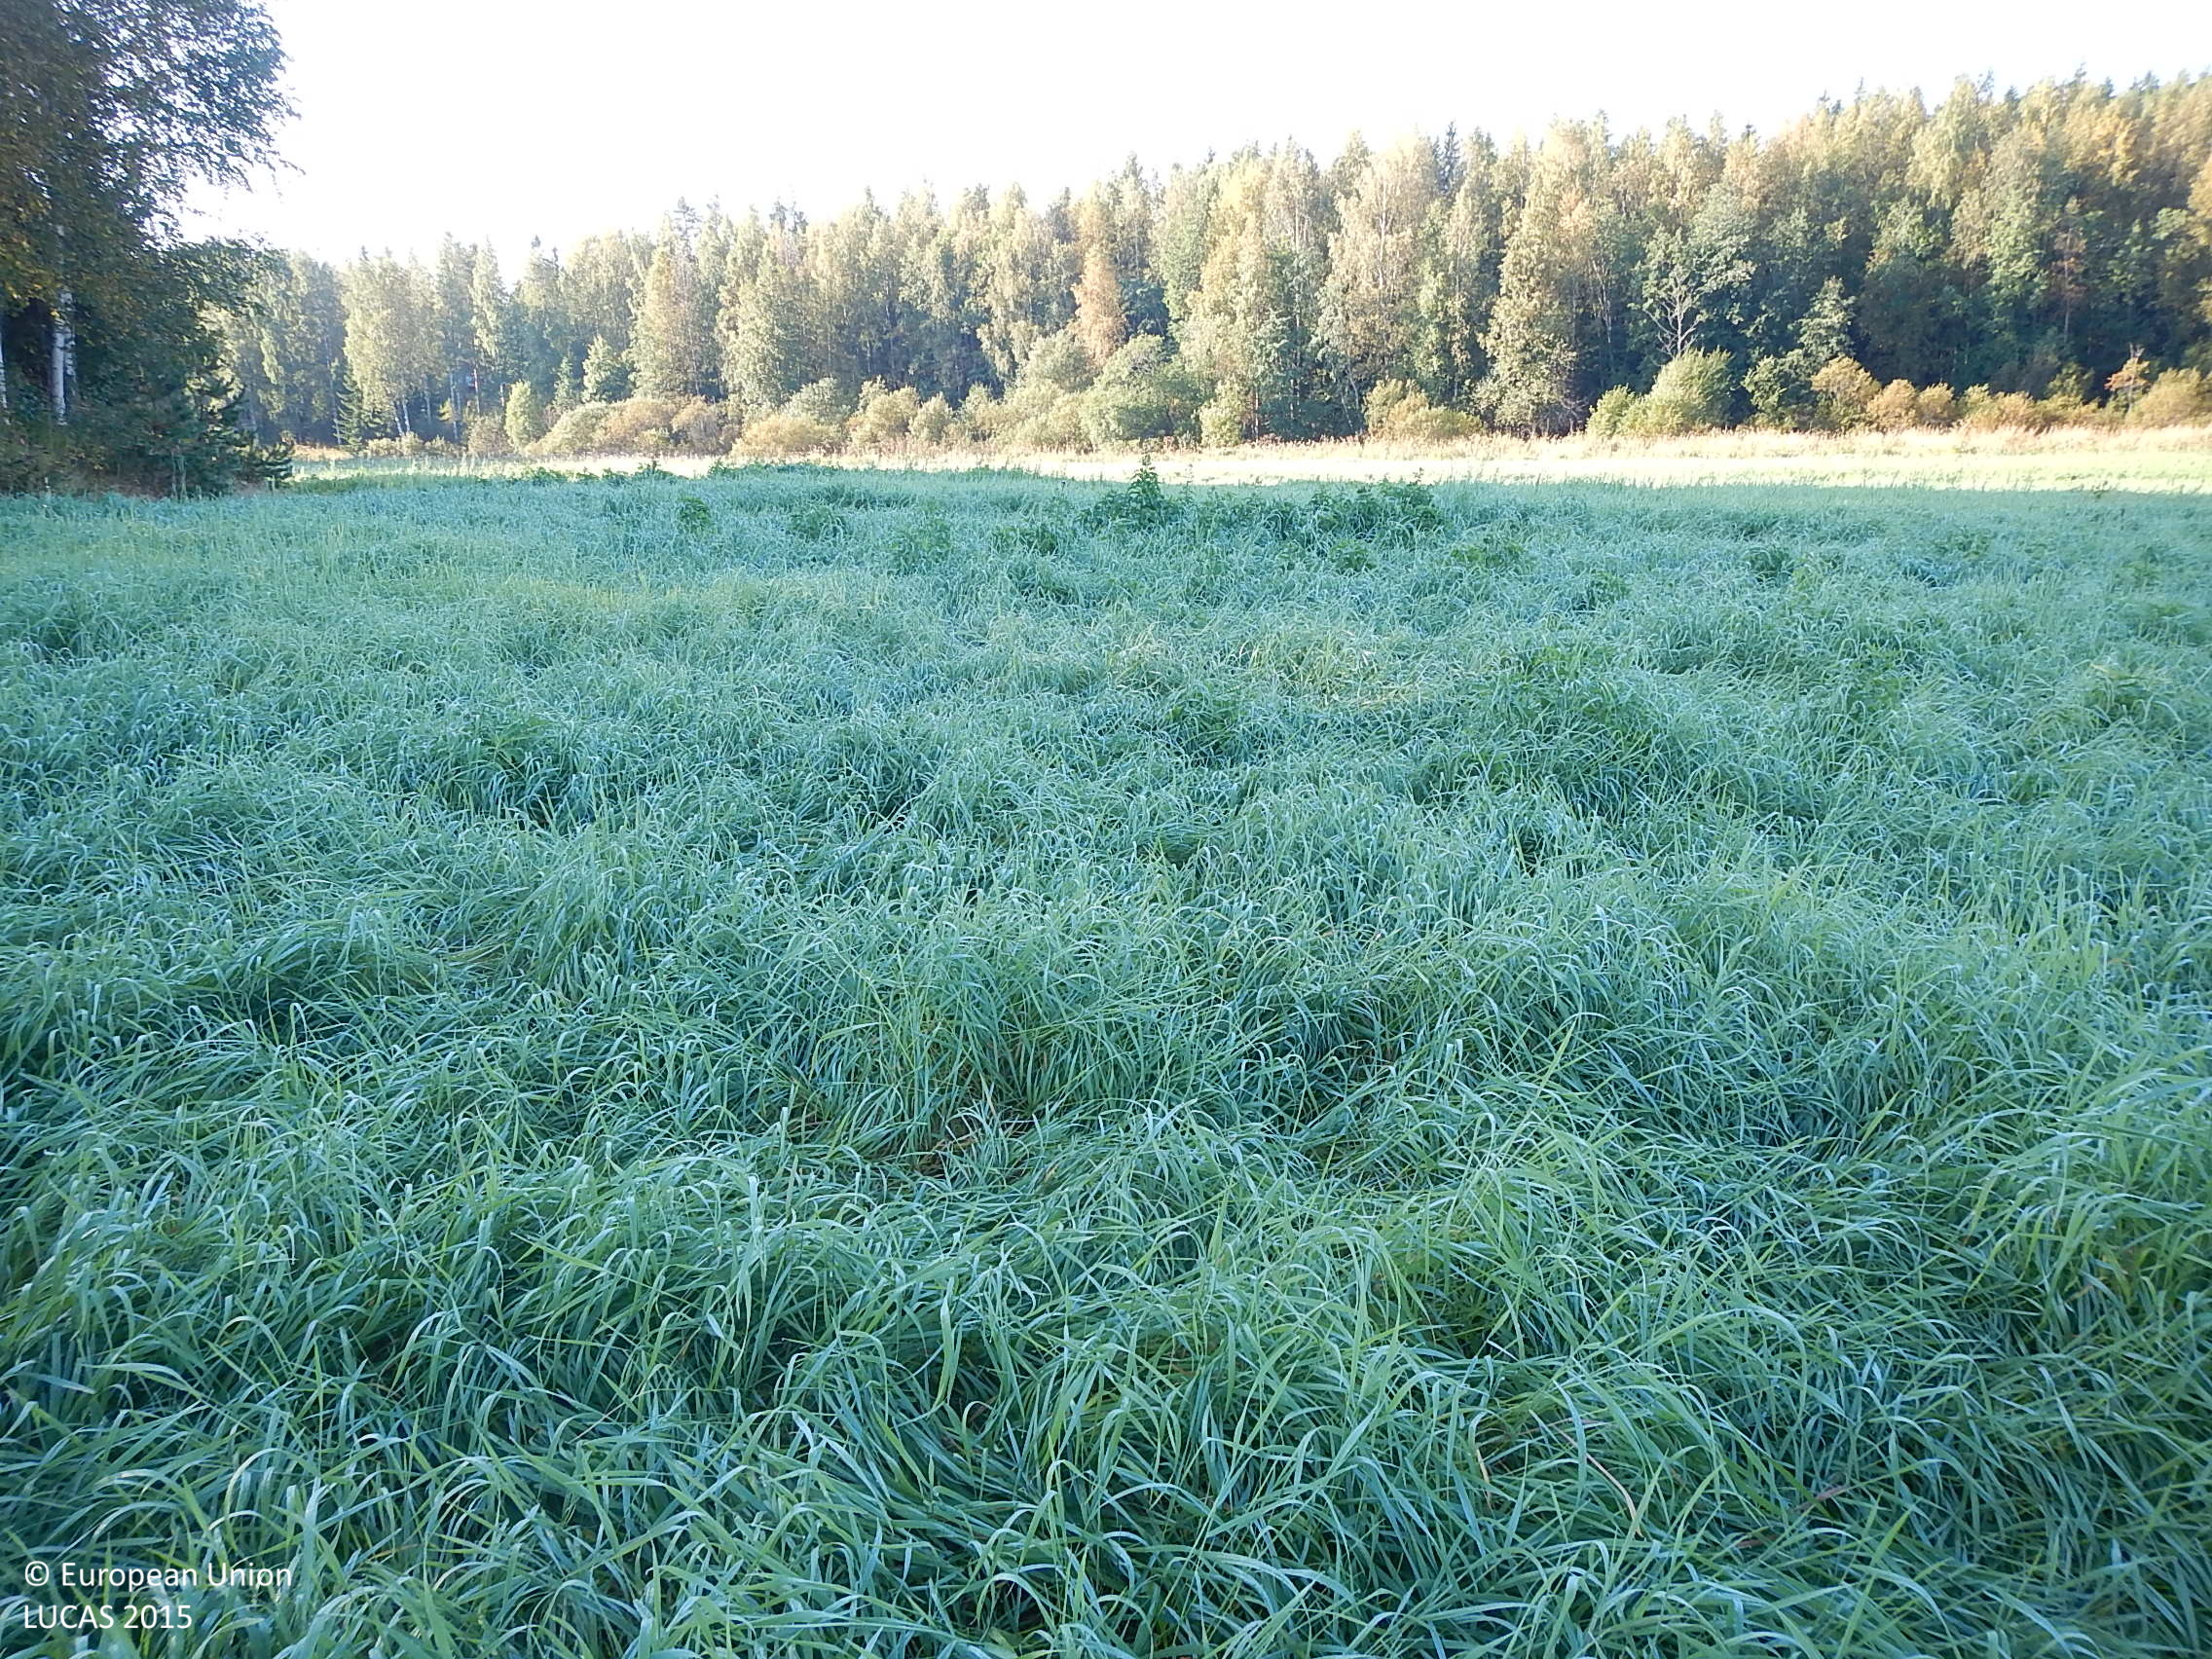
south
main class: Cropland
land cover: Temporary grasslands
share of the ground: > 75 %
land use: Agriculture (excluding fallow land and kitchen gardens)
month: September
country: FI
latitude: 61.6458
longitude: 22.1183
